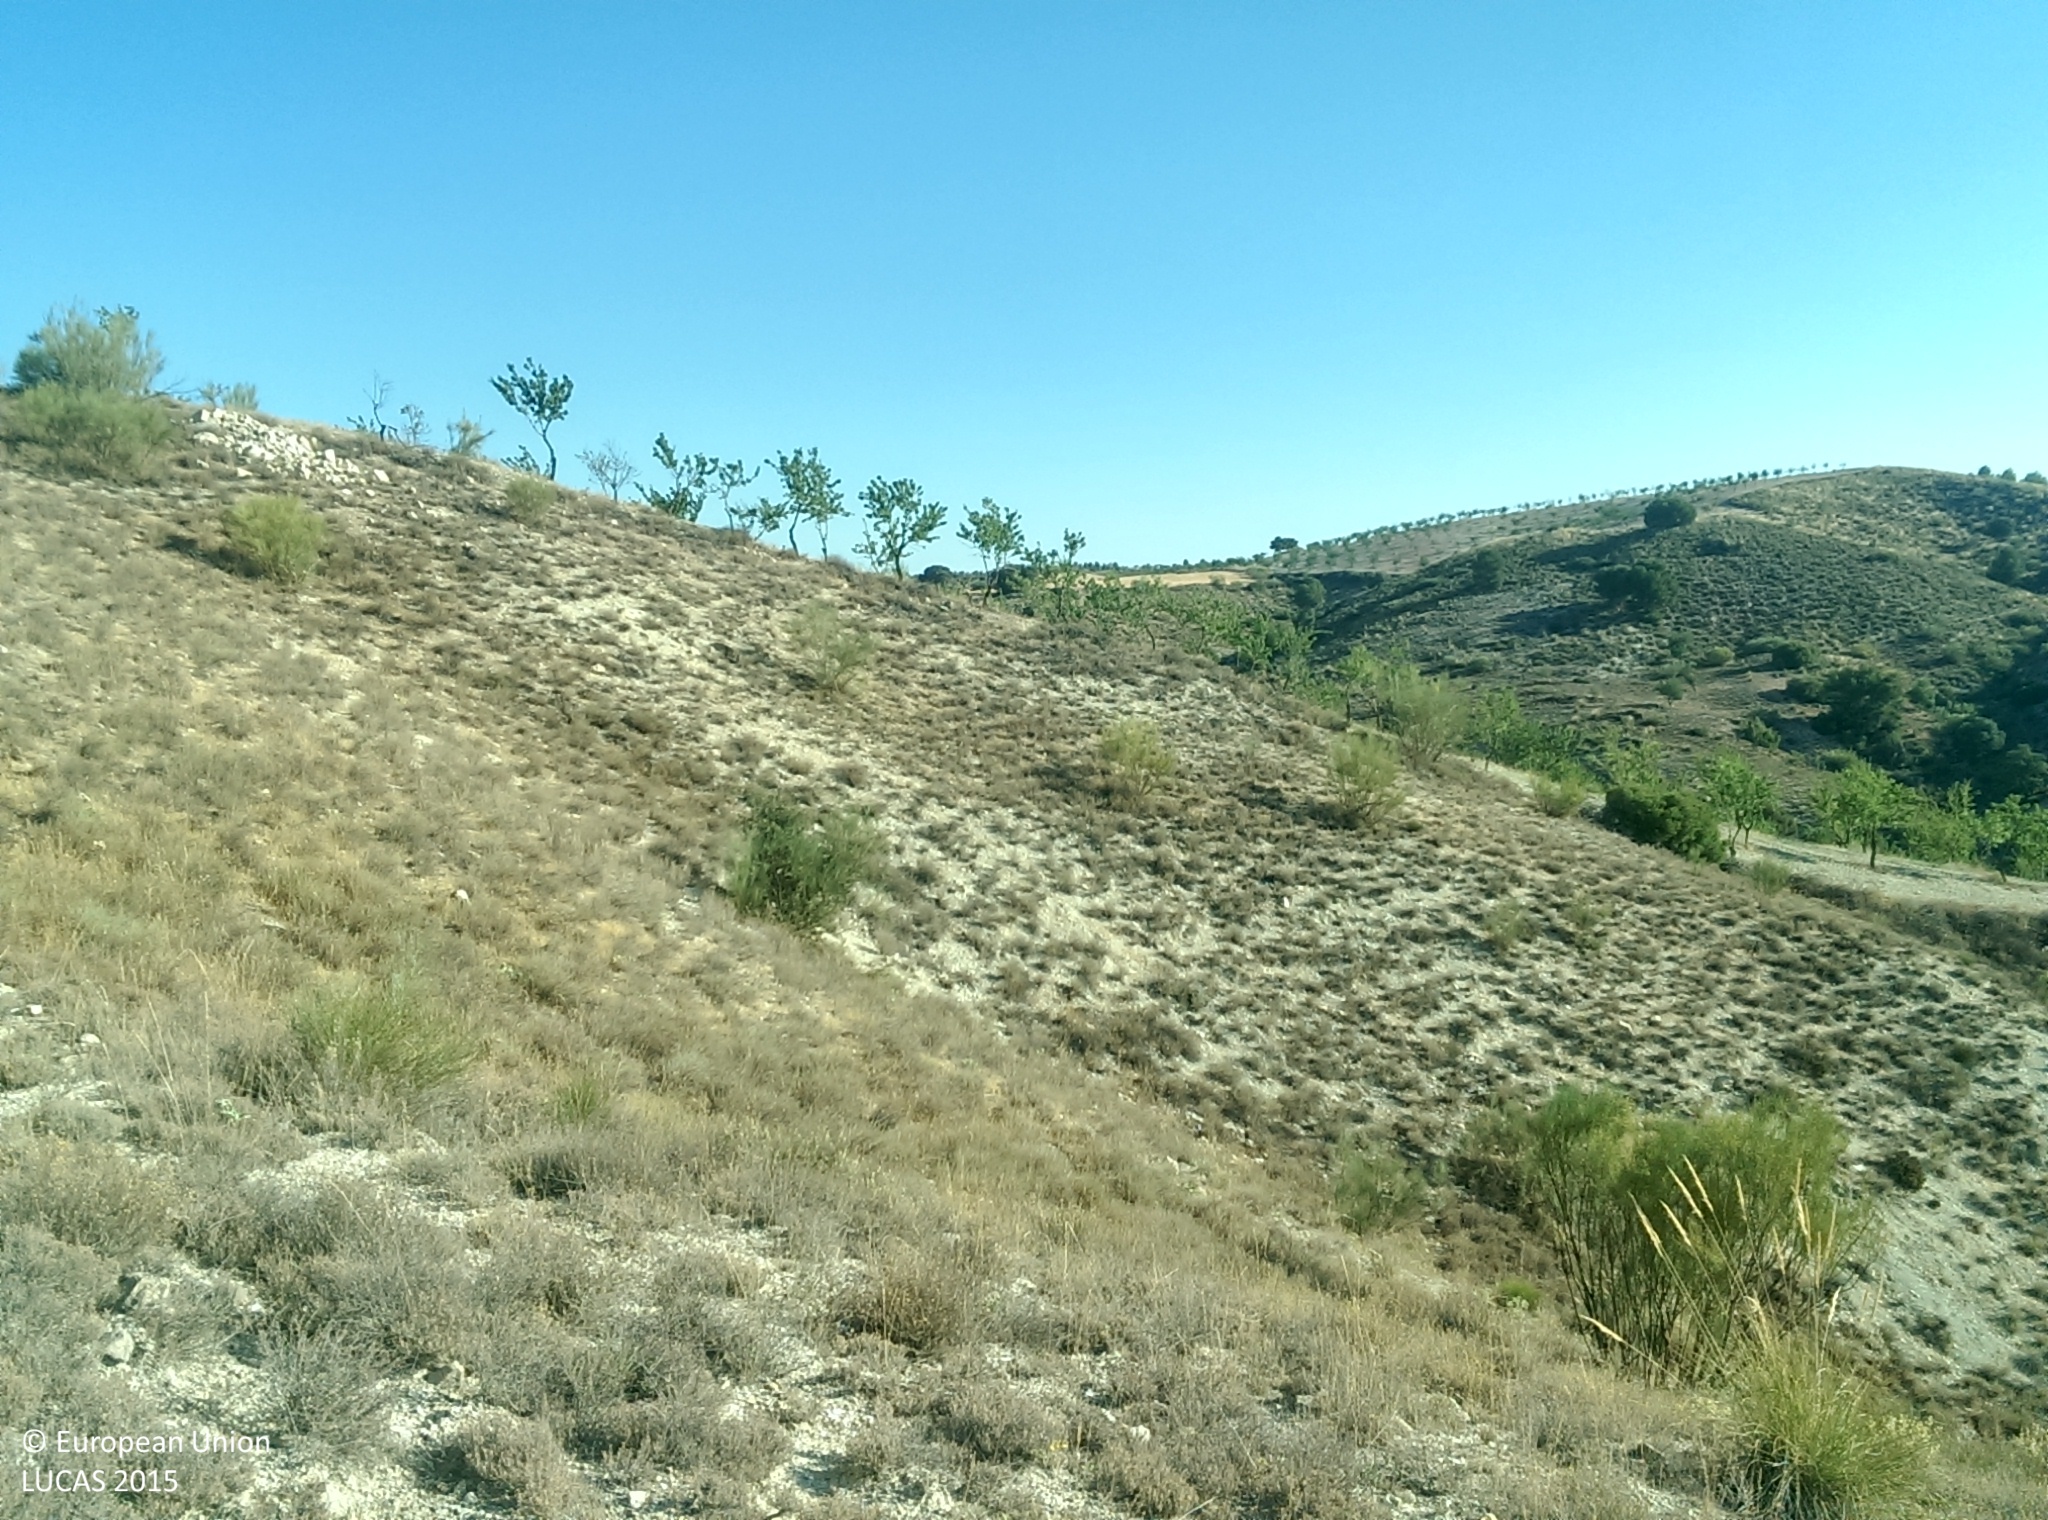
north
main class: Shrubland
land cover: Shrubland without tree cover
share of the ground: > 75 %
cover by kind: shrubs 90 %, unconsolidated bare surface 10 %
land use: Agriculture (excluding fallow land and kitchen gardens)
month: June
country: ES
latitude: 37.5807
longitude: -3.1611
